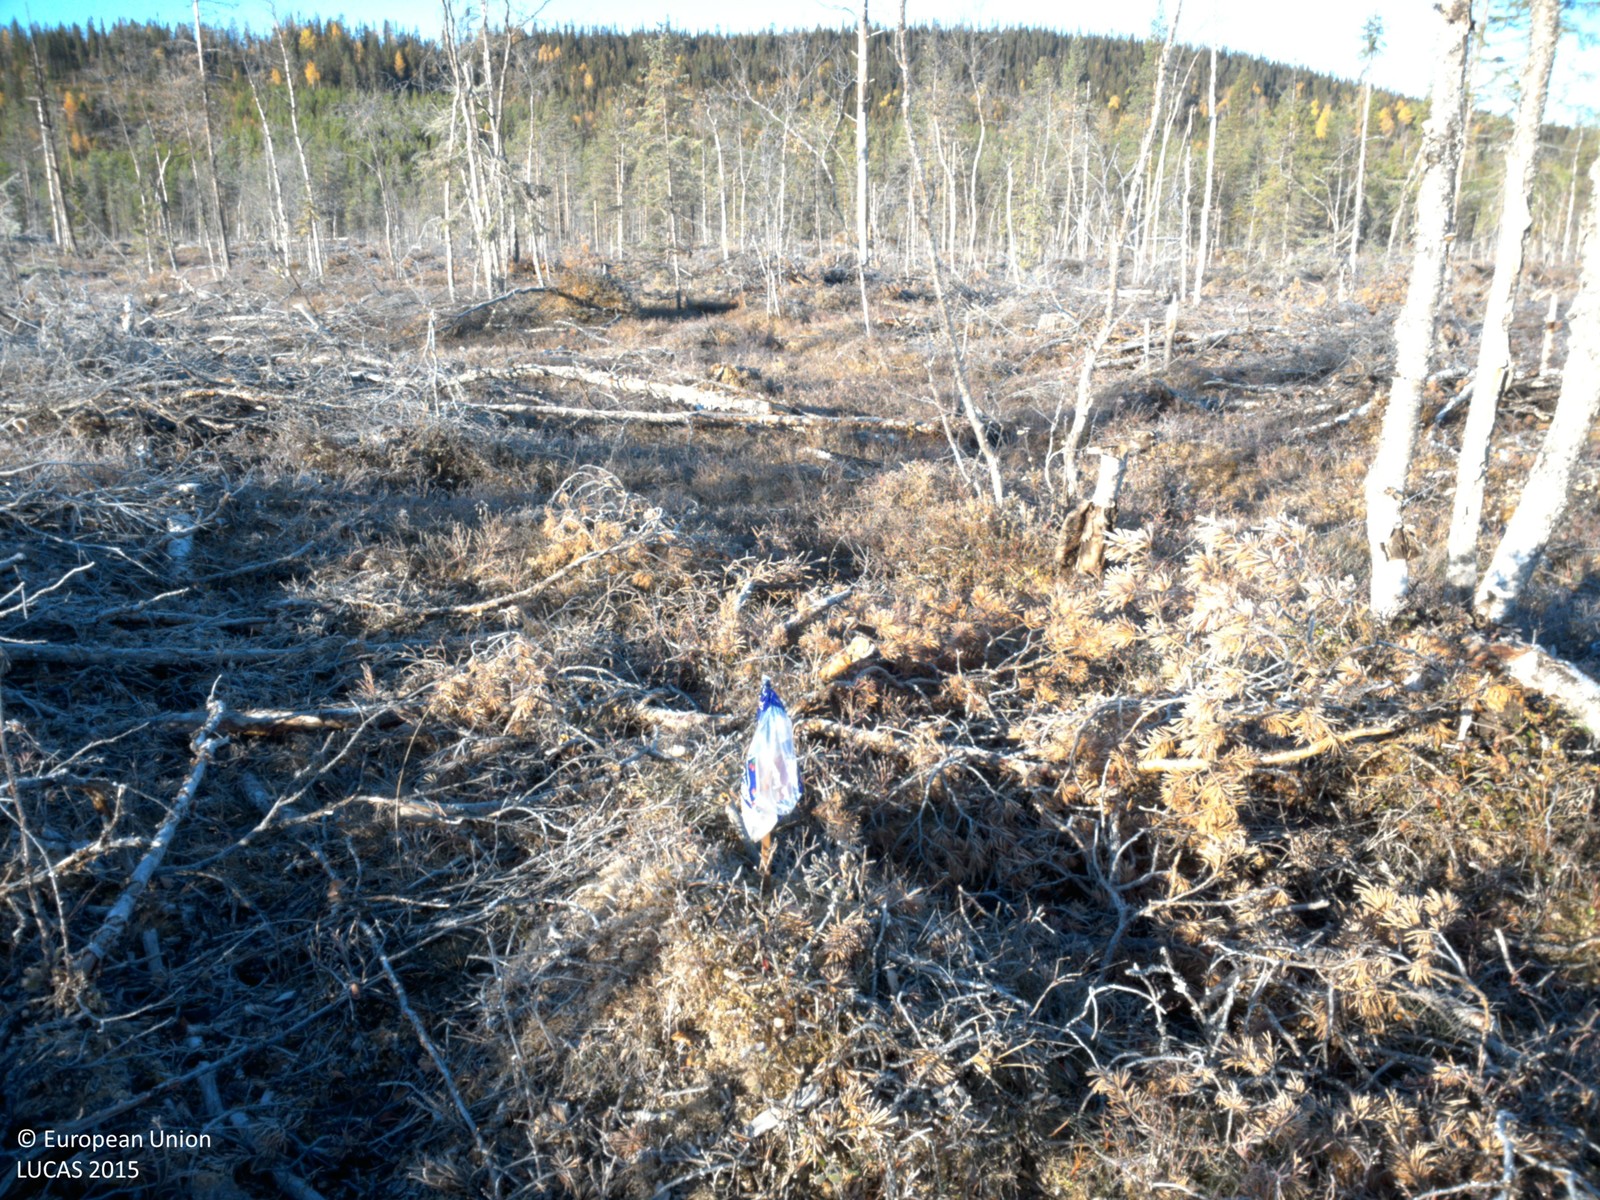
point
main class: Shrubland
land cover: Shrubland with sparse tree cover
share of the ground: 10 - 25 %
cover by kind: shrubs 10 %, coniferous forest trees 5 %
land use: Forestry
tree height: < 5 m
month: October
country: SE
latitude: 64.7331
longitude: 17.7976
